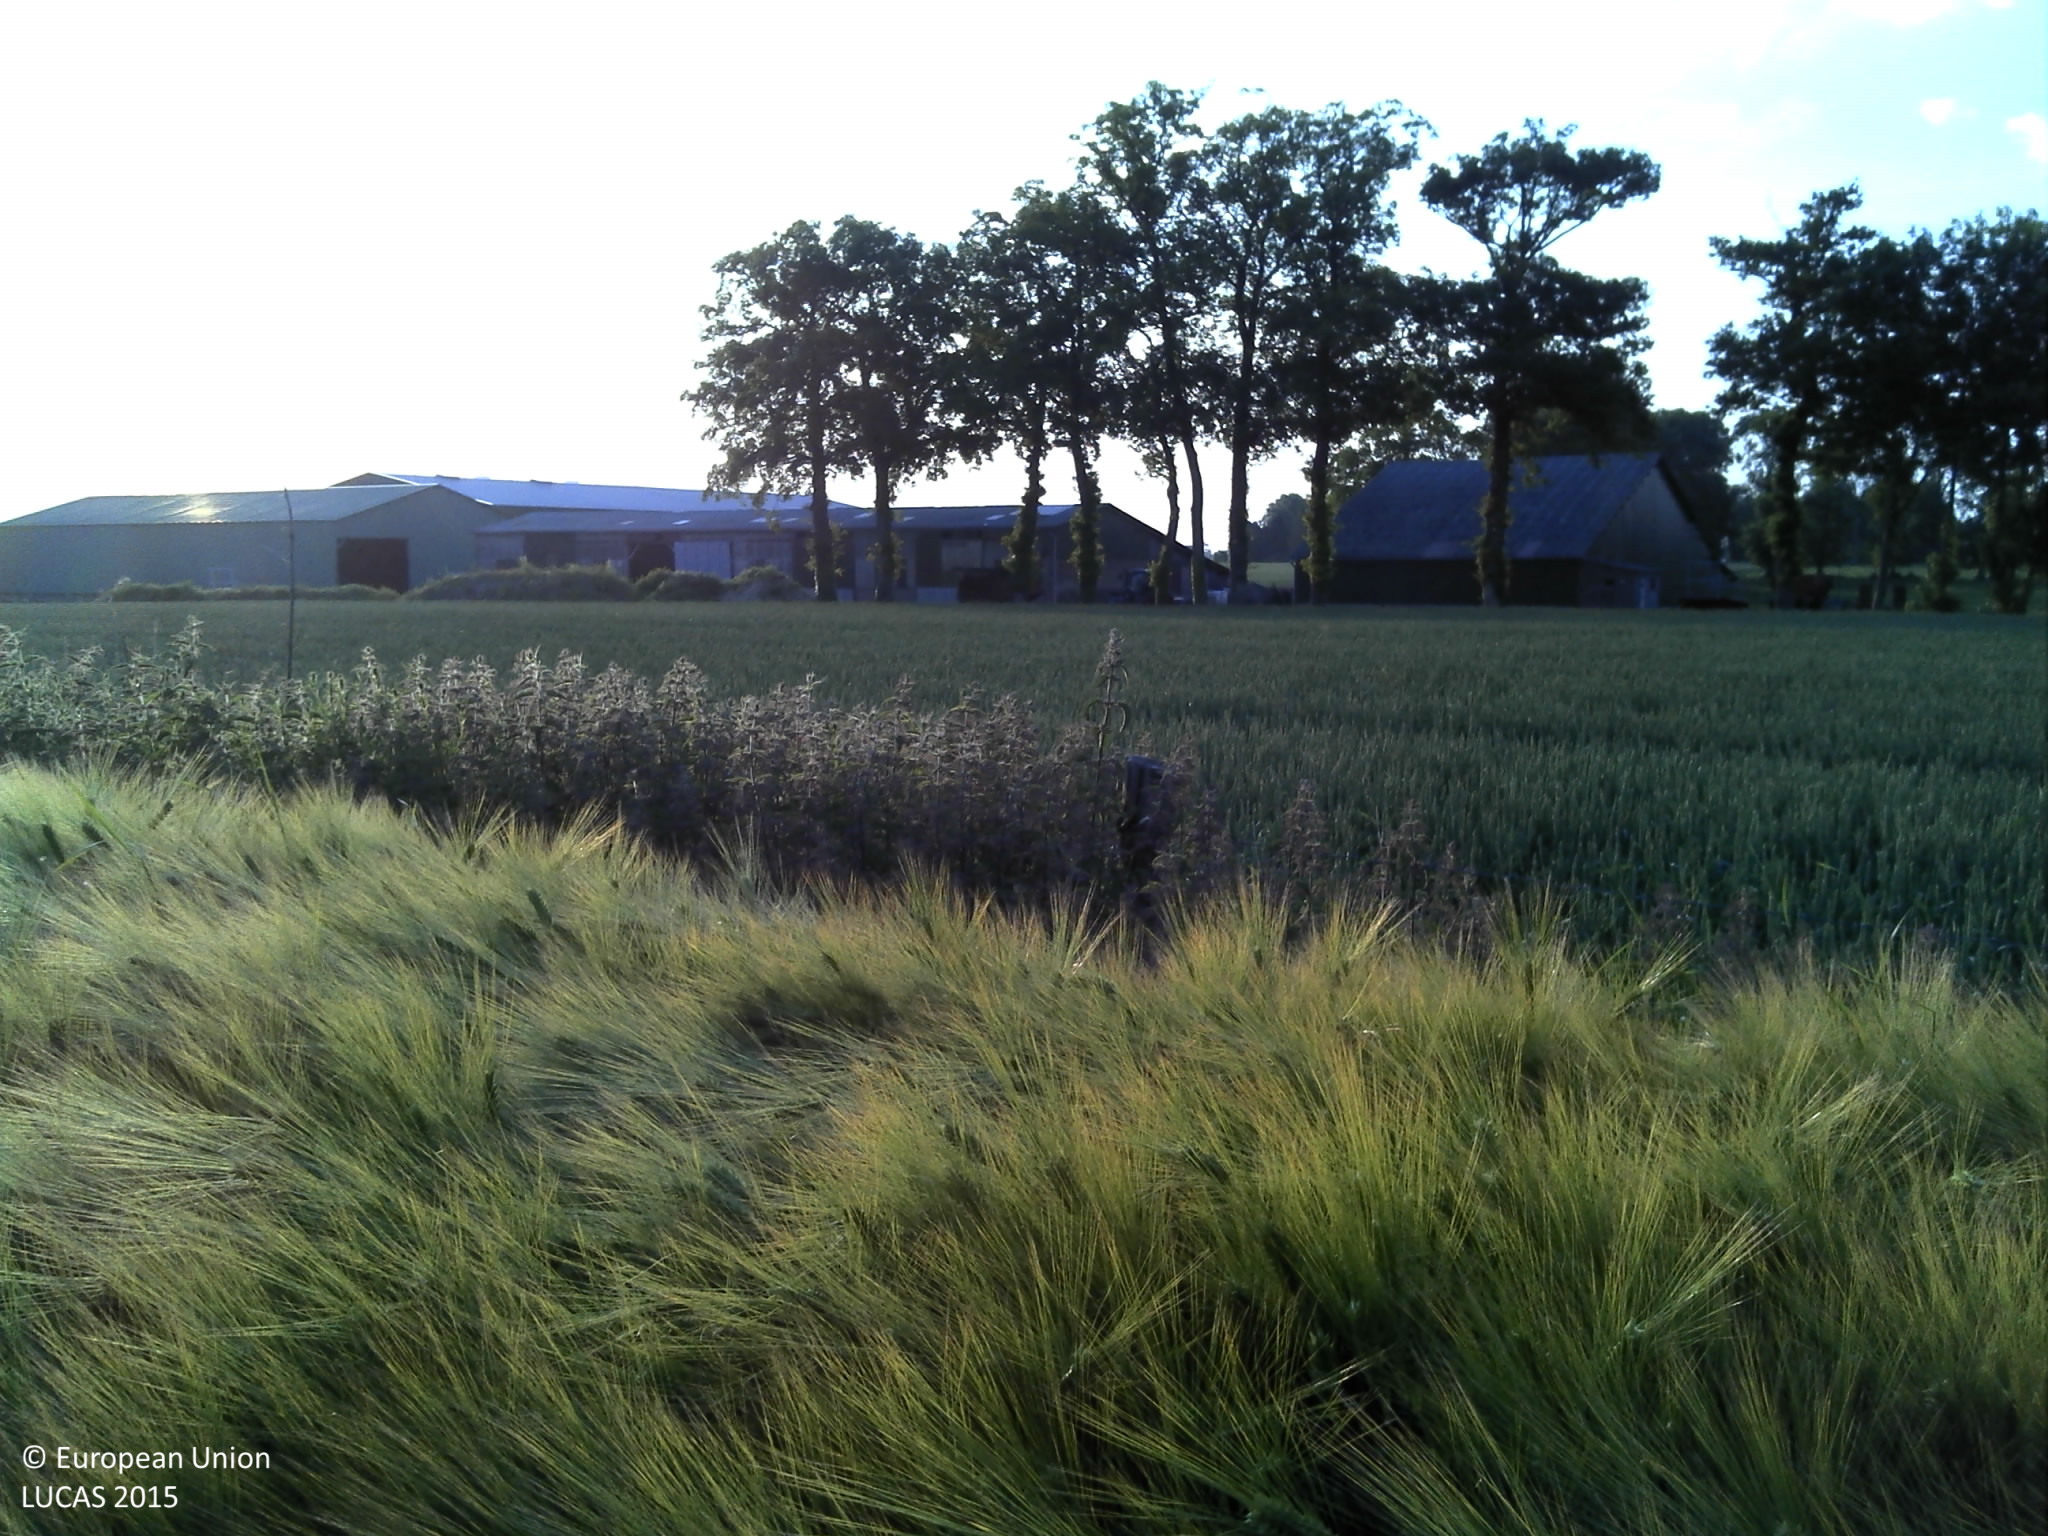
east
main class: Cropland
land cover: Barley
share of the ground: > 75 %
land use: Agriculture (excluding fallow land and kitchen gardens)
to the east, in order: Barley; Grass margins; Fences; Grass margins; Common wheat; Managed hedges; Artificial constructions in urban areas; Grassland without tree/shrub cover; Fences; Grassland without tree/shrub cover
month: June
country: FR
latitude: 49.6703
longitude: 1.0685
